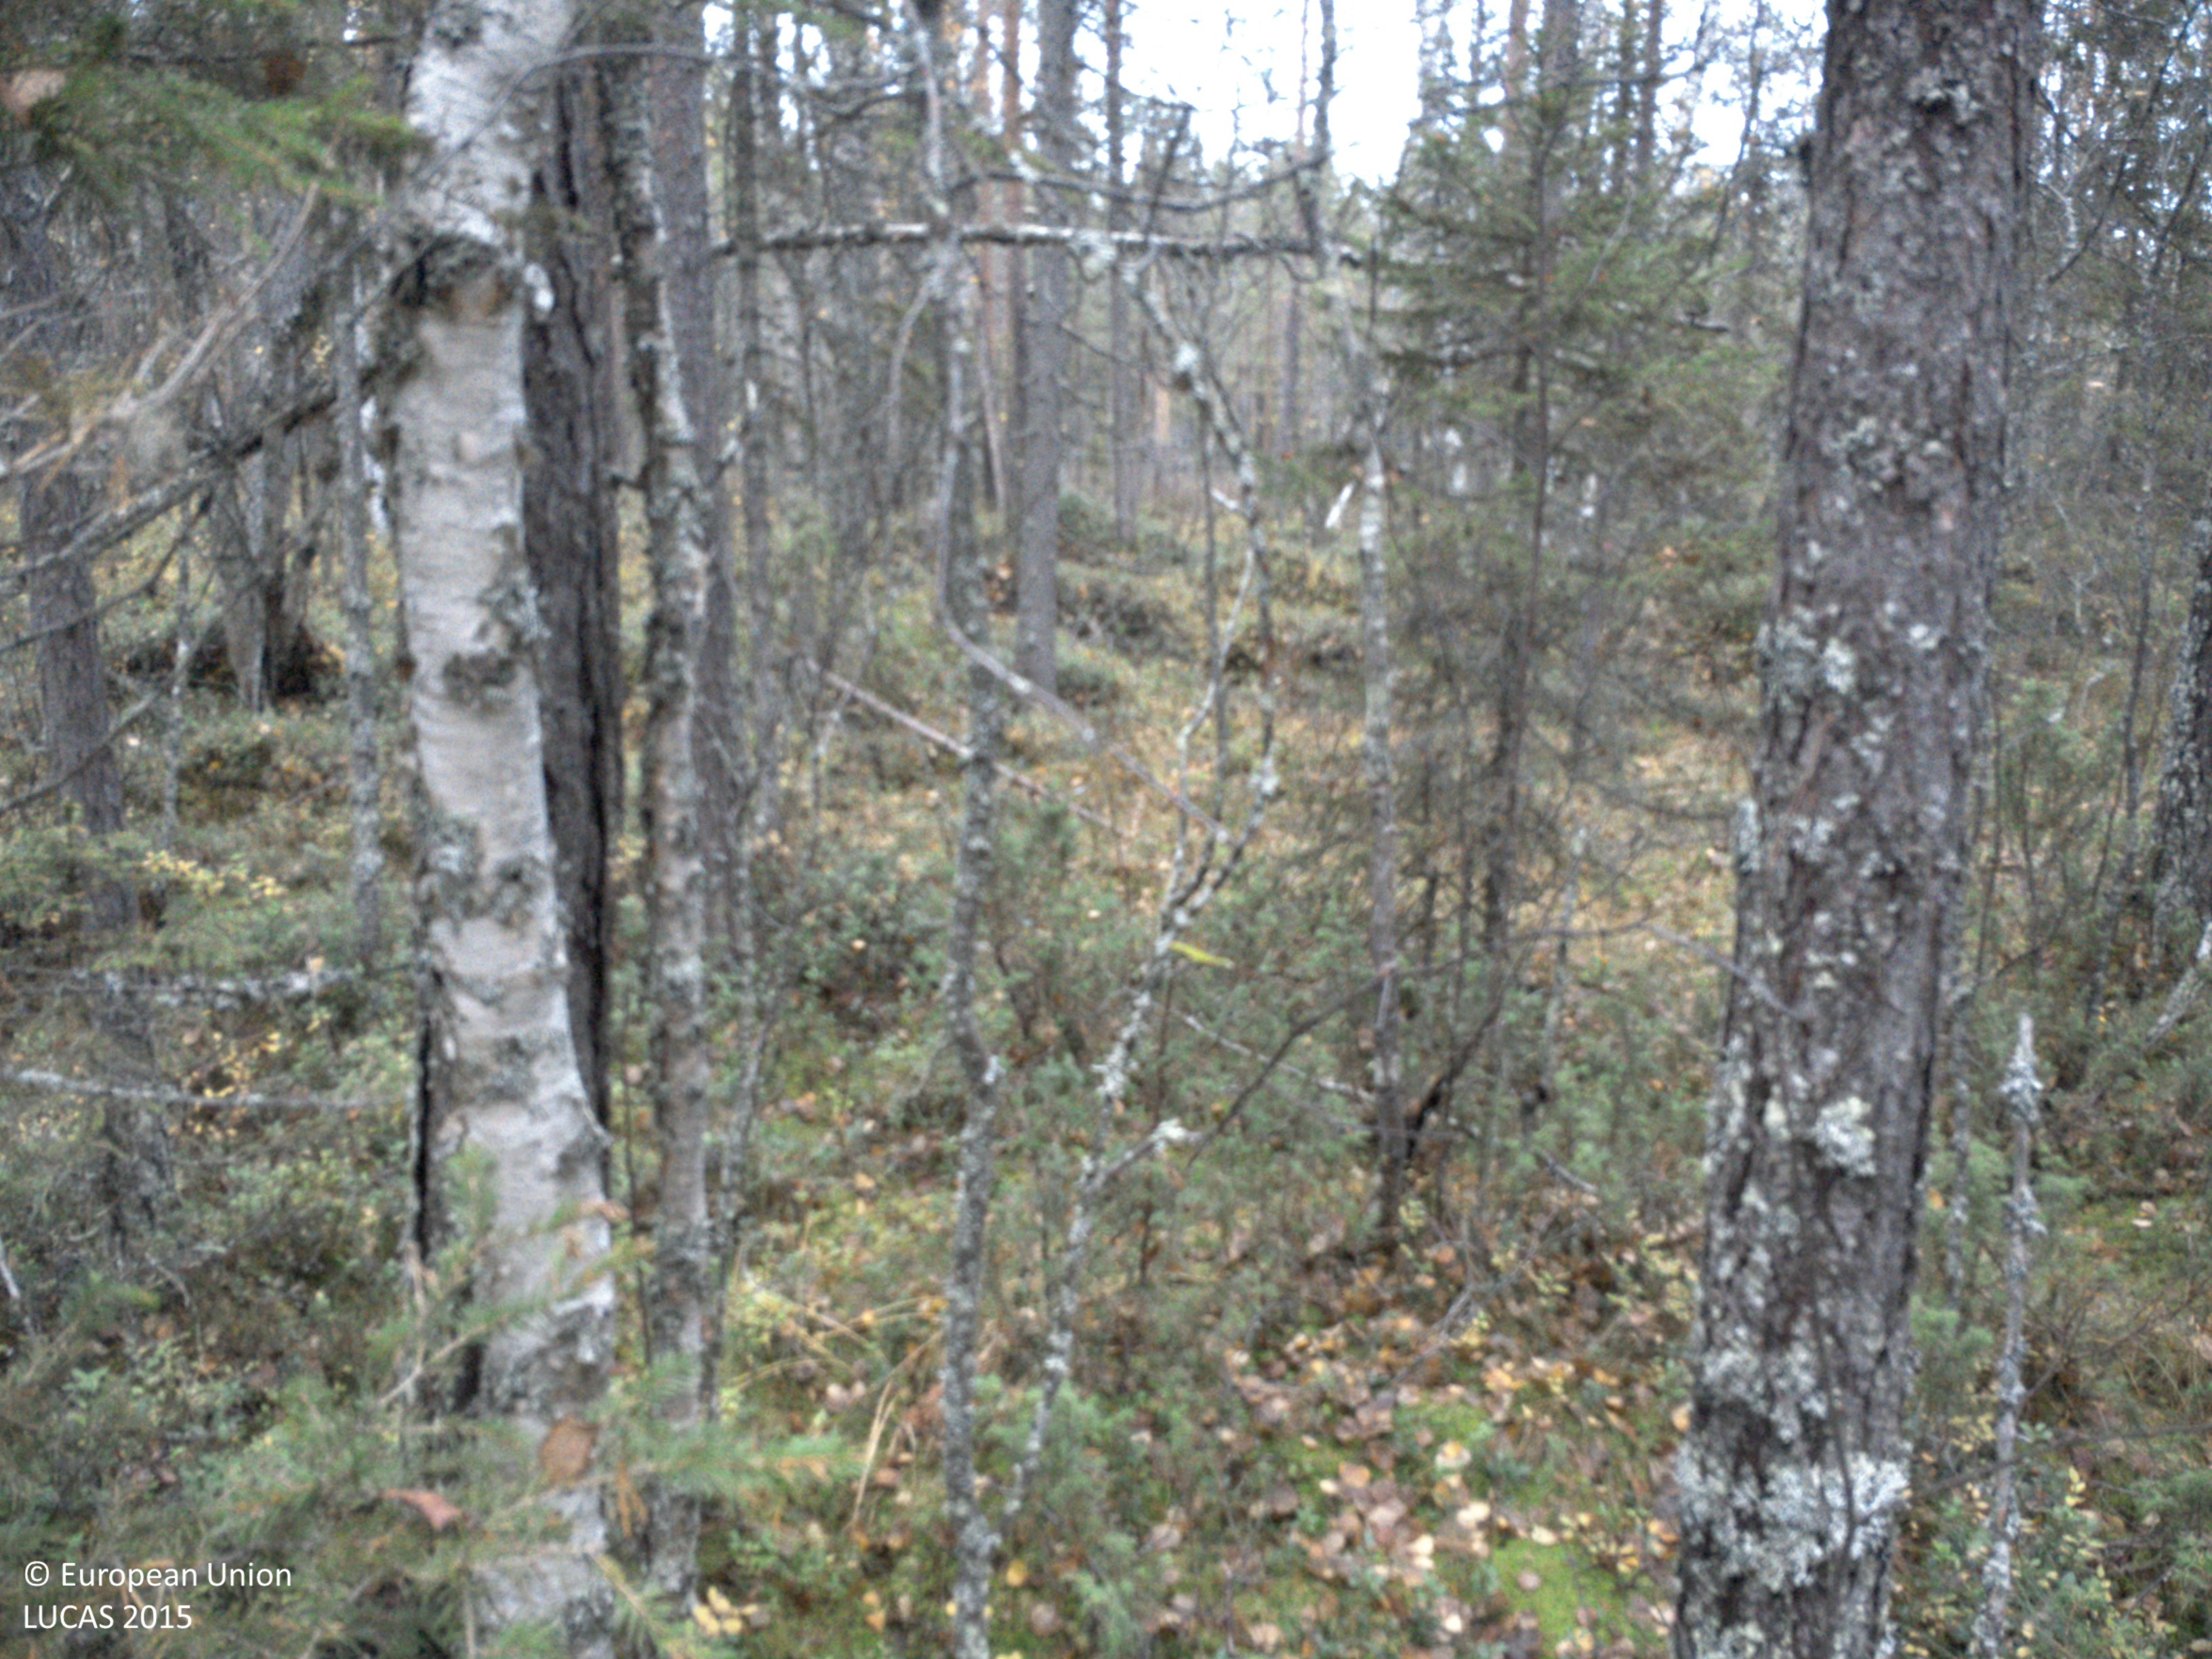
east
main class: Woodland
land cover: Pine dominated mixed woodland
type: boreal forest
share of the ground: > 75 %
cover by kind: coniferous forest trees 60 %, broadleaved forest trees 20 %, shrubs 10 %, herbaceous plants 5 %, lichens and mosses 5 %
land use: Forestry
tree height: > 5 m
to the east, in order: Pine dominated mixed woodland; Pine dominated coniferous woodland; Spruce dominated coniferous woodland; Pine dominated mixed woodland; Ditches and canals; Pine dominated mixed woodland; Pine dominated coniferous woodland
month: September
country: SE
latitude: 64.8404
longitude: 18.8837
